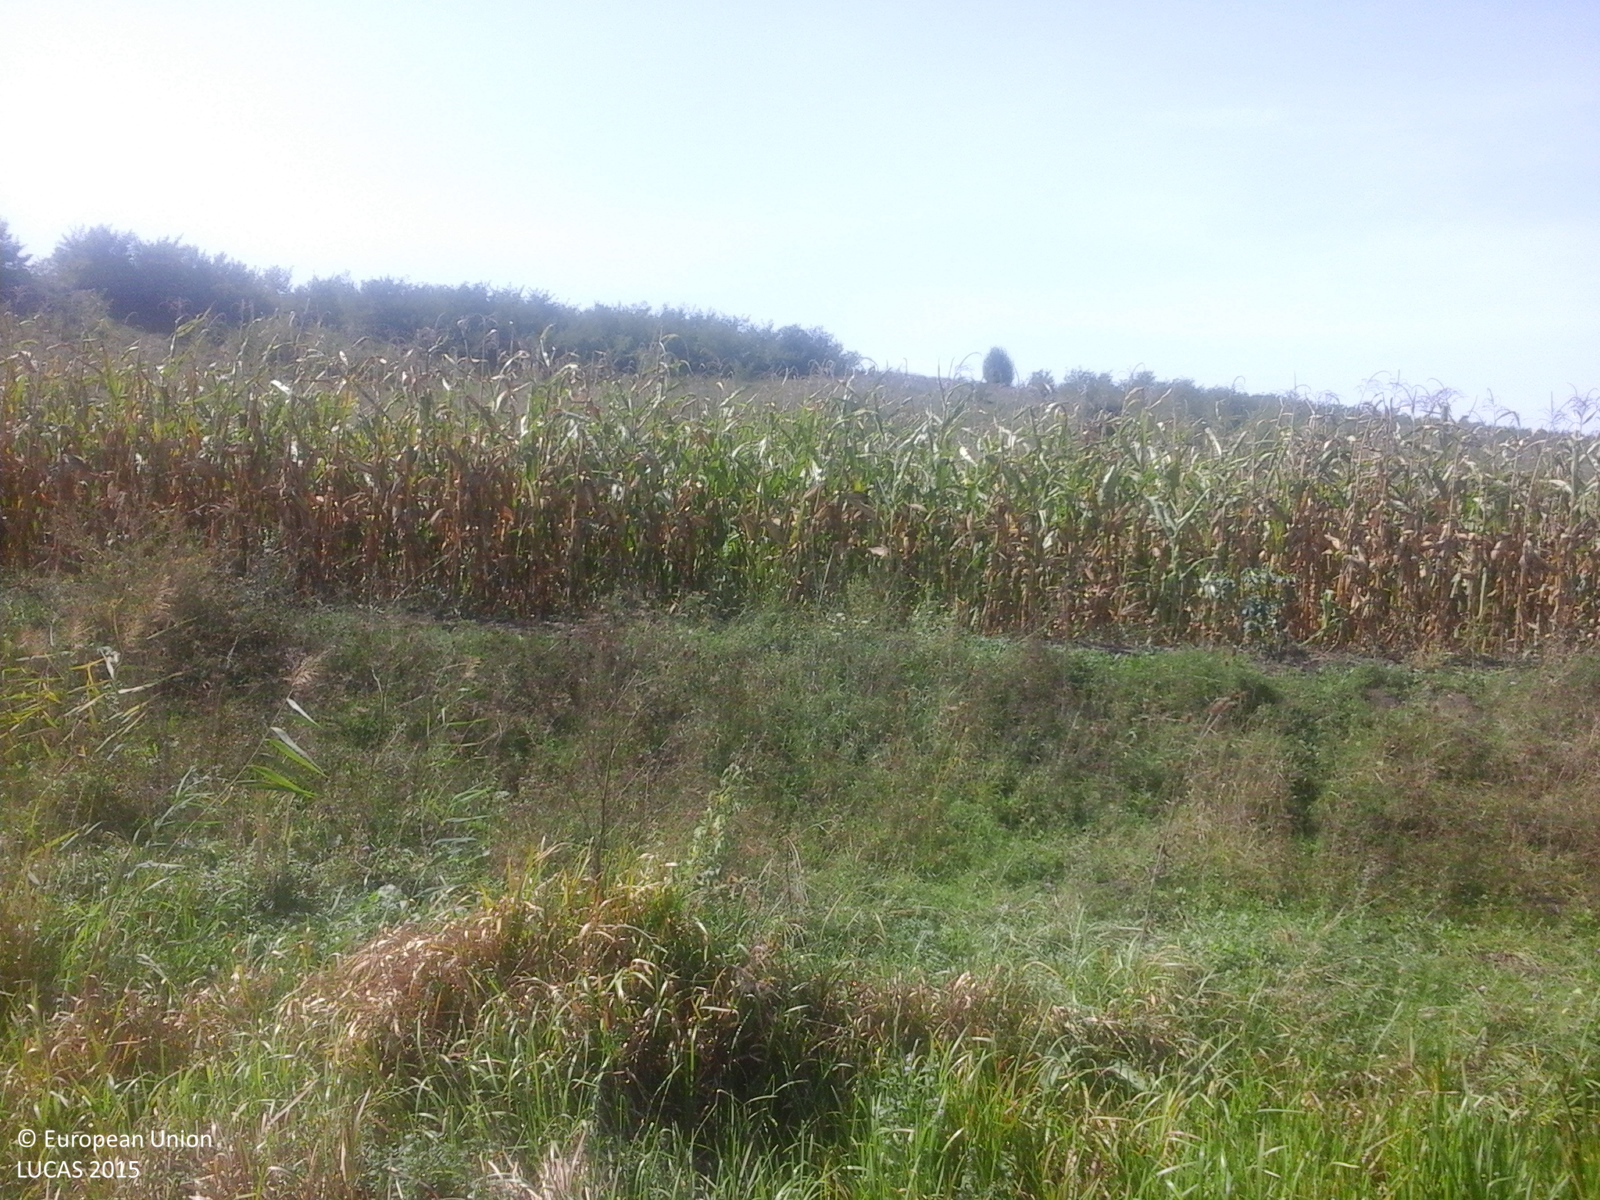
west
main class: Cropland
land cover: Maize
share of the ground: > 75 %
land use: Agriculture (excluding fallow land and kitchen gardens)
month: September
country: RO
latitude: 46.7249
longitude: 24.2536
